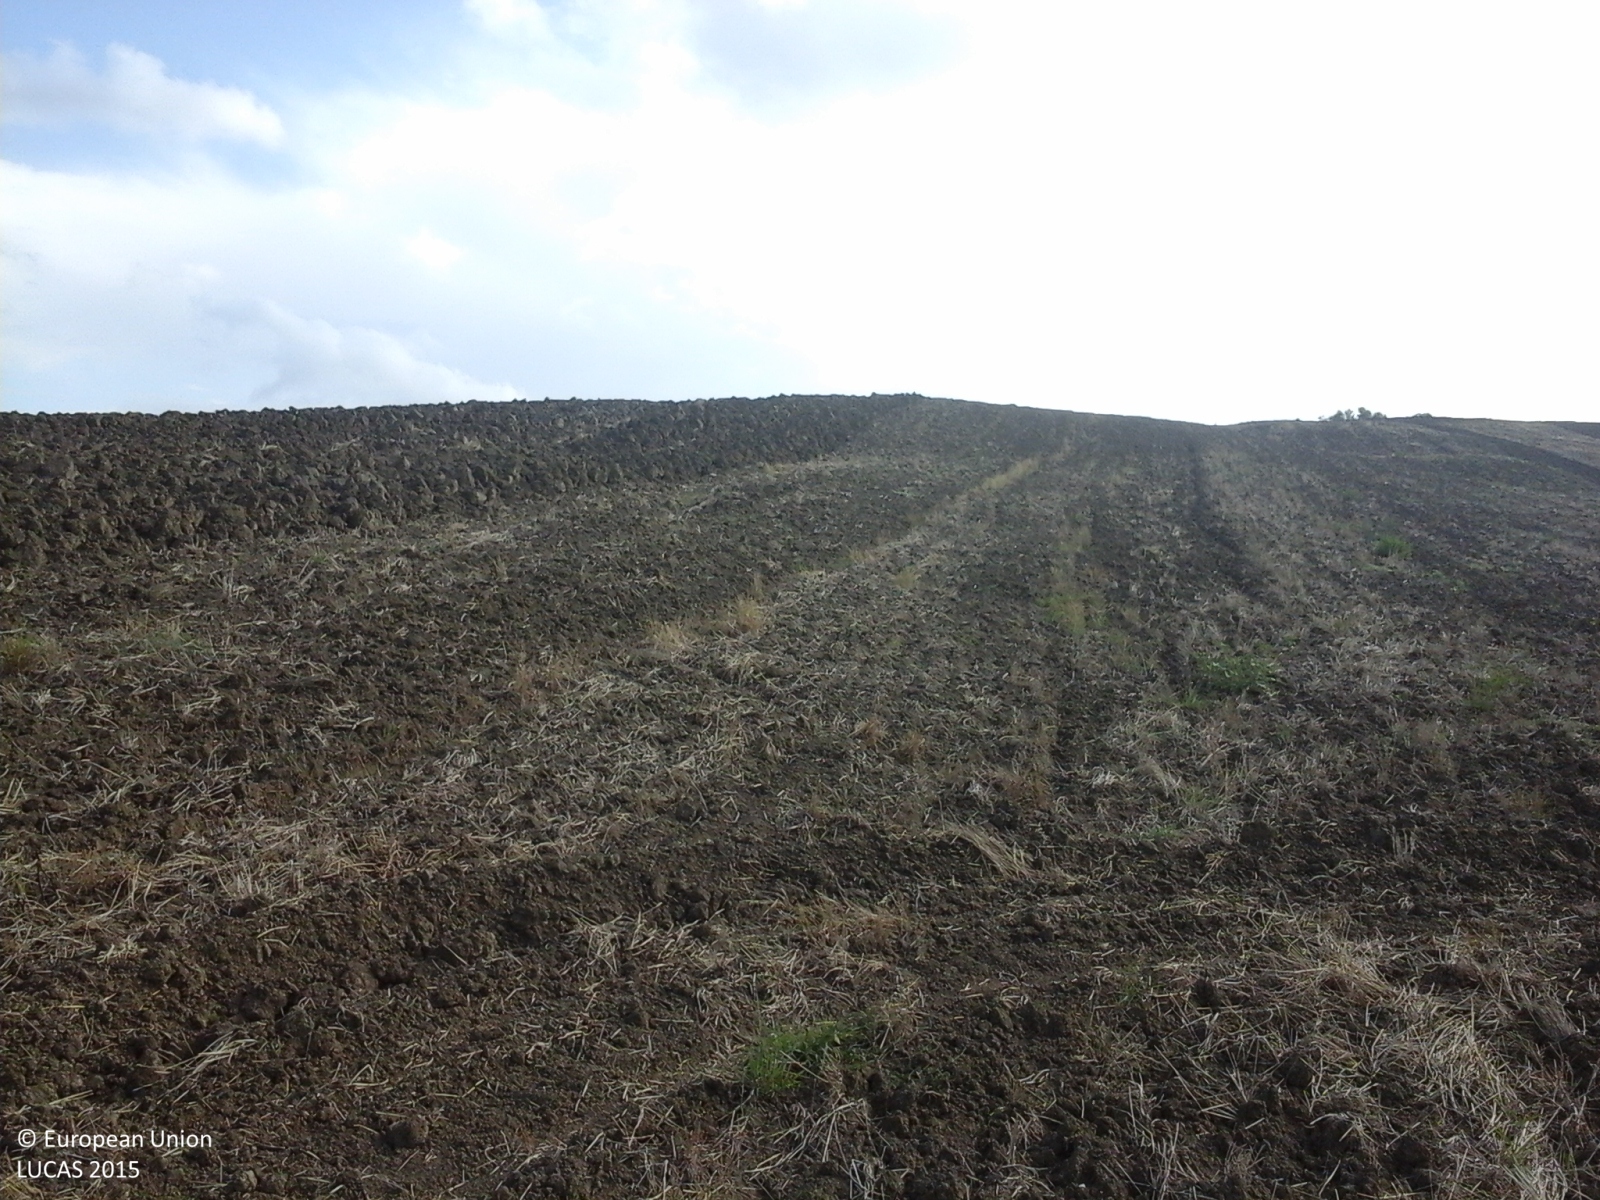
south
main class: Cropland
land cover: Dry pulses
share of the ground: < 10 %
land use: Agriculture (excluding fallow land and kitchen gardens)
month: August
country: IT
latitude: 43.4694
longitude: 13.2429
